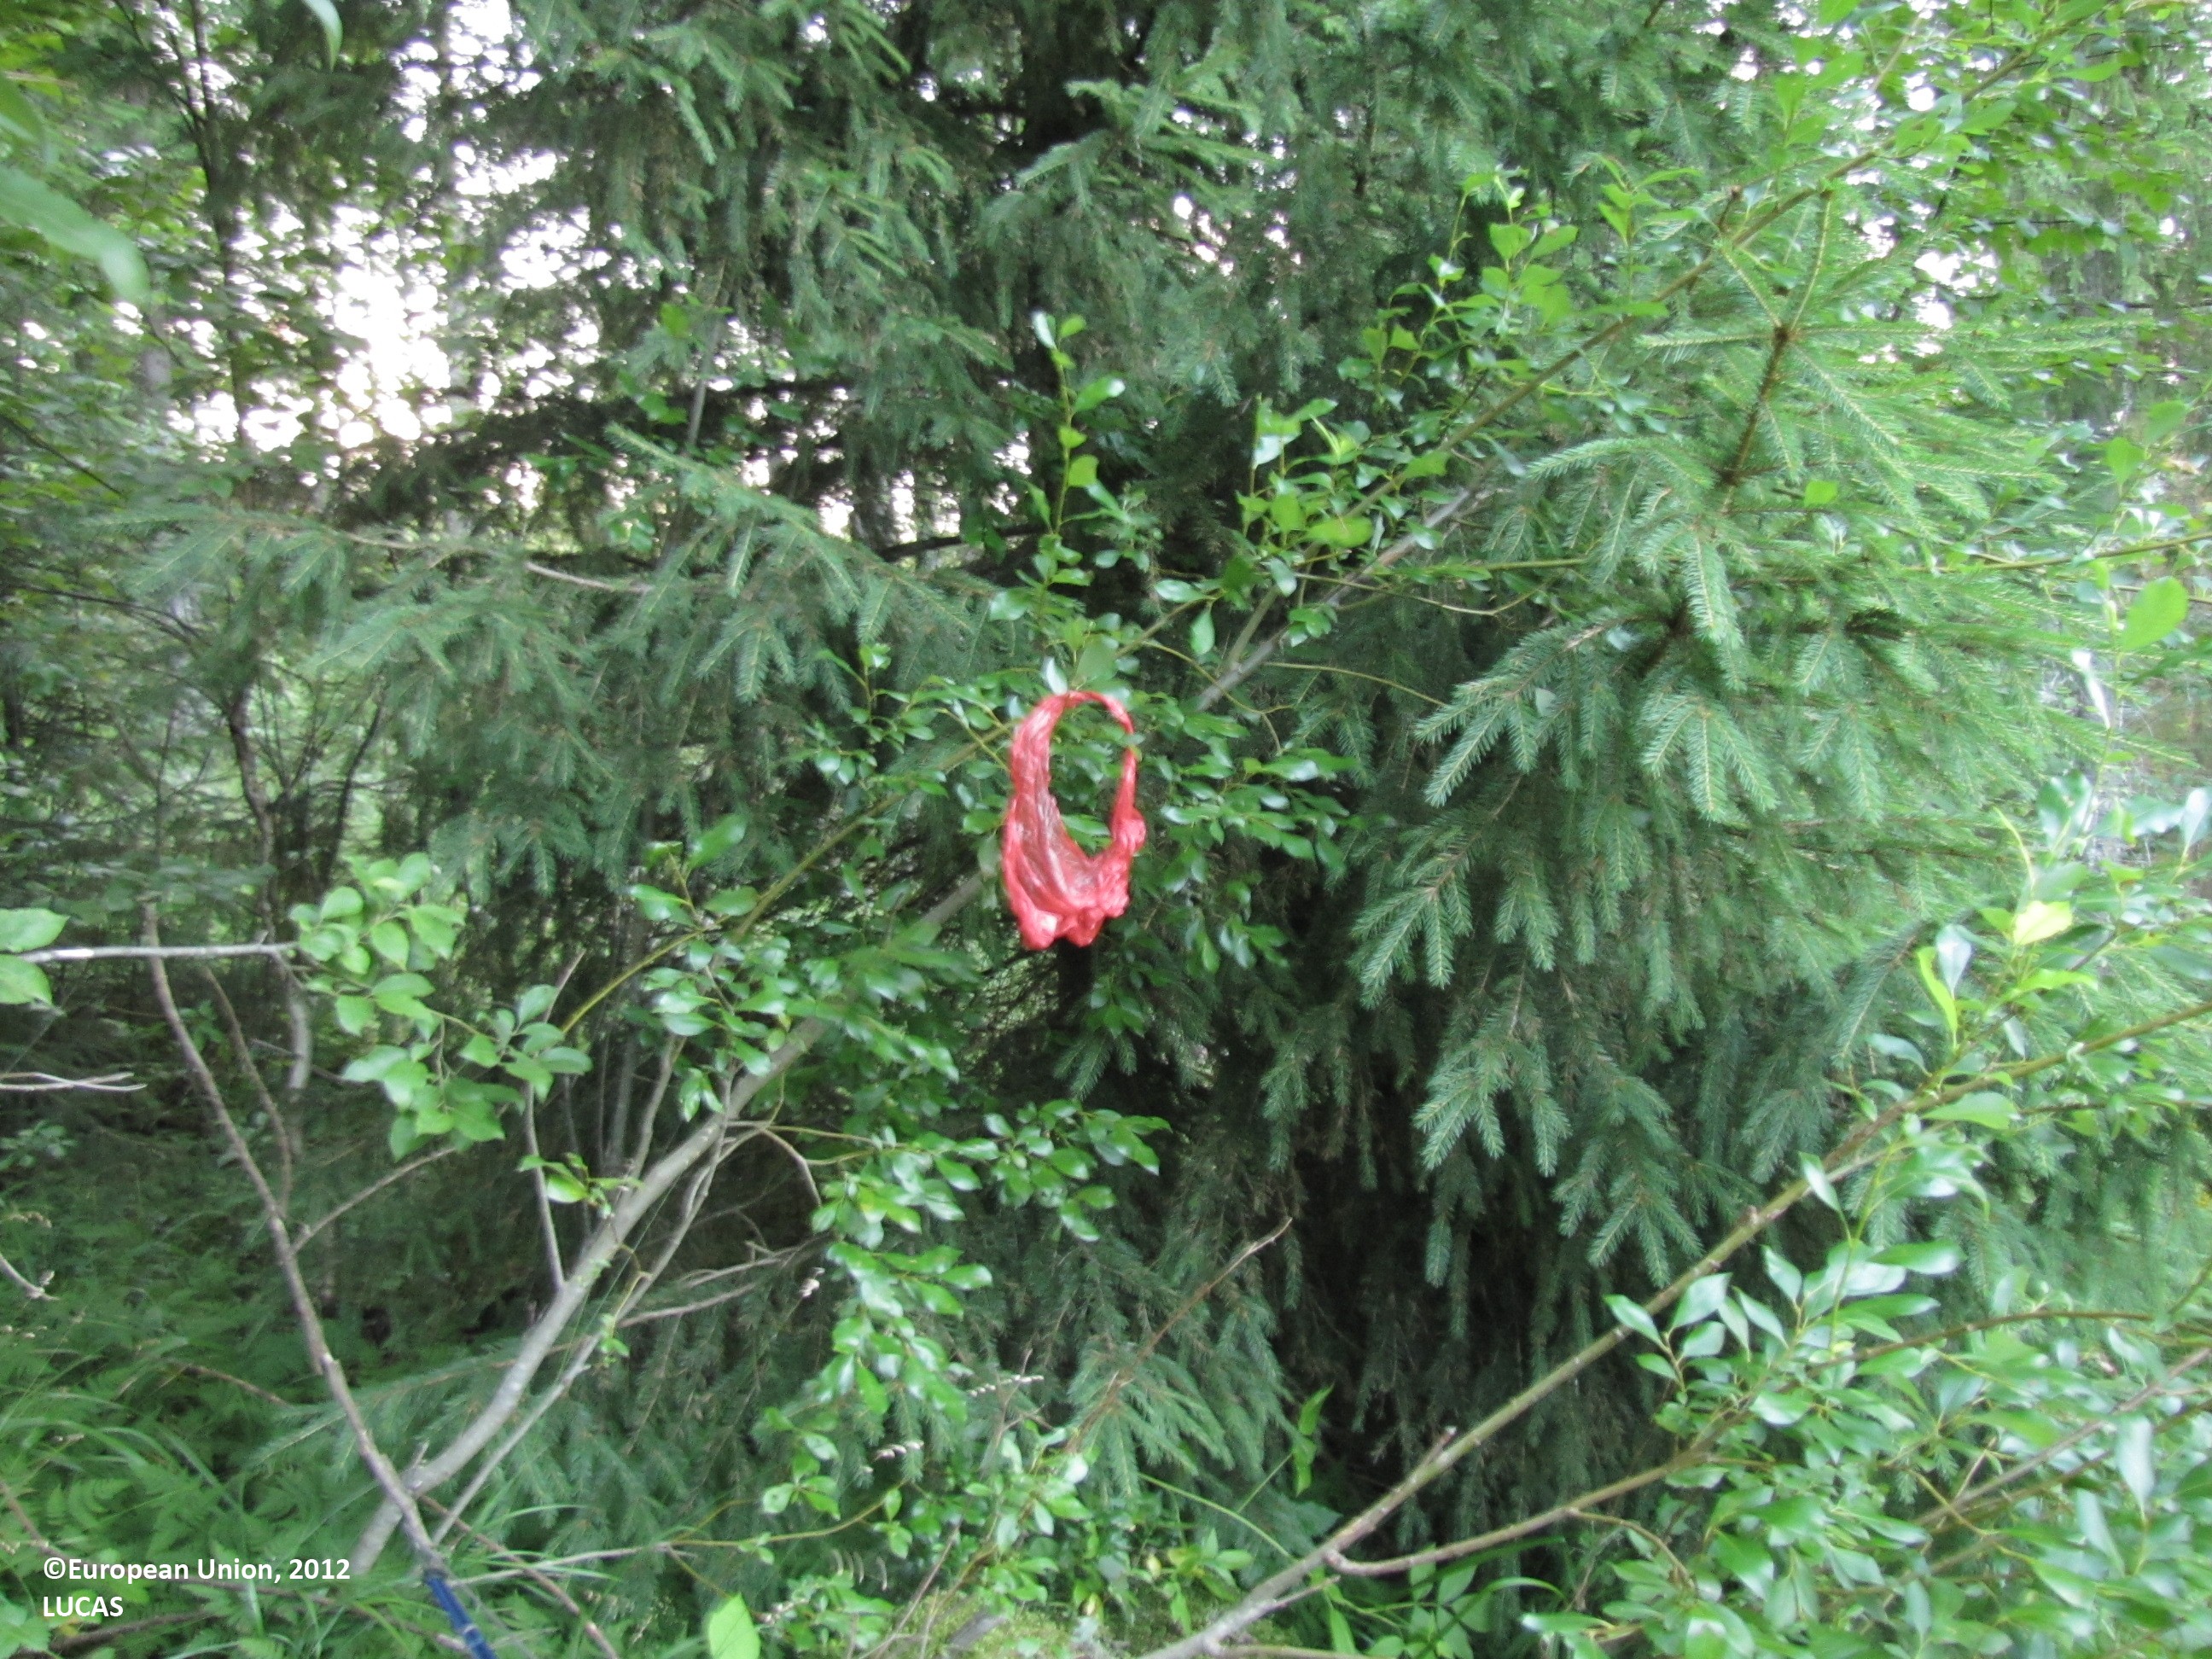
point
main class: Woodland
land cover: Other mixed woodland
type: boreal forest
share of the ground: 25 - 50 %
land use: Forestry
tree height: > 5 m
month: July
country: FI
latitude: 61.9661
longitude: 23.8717
